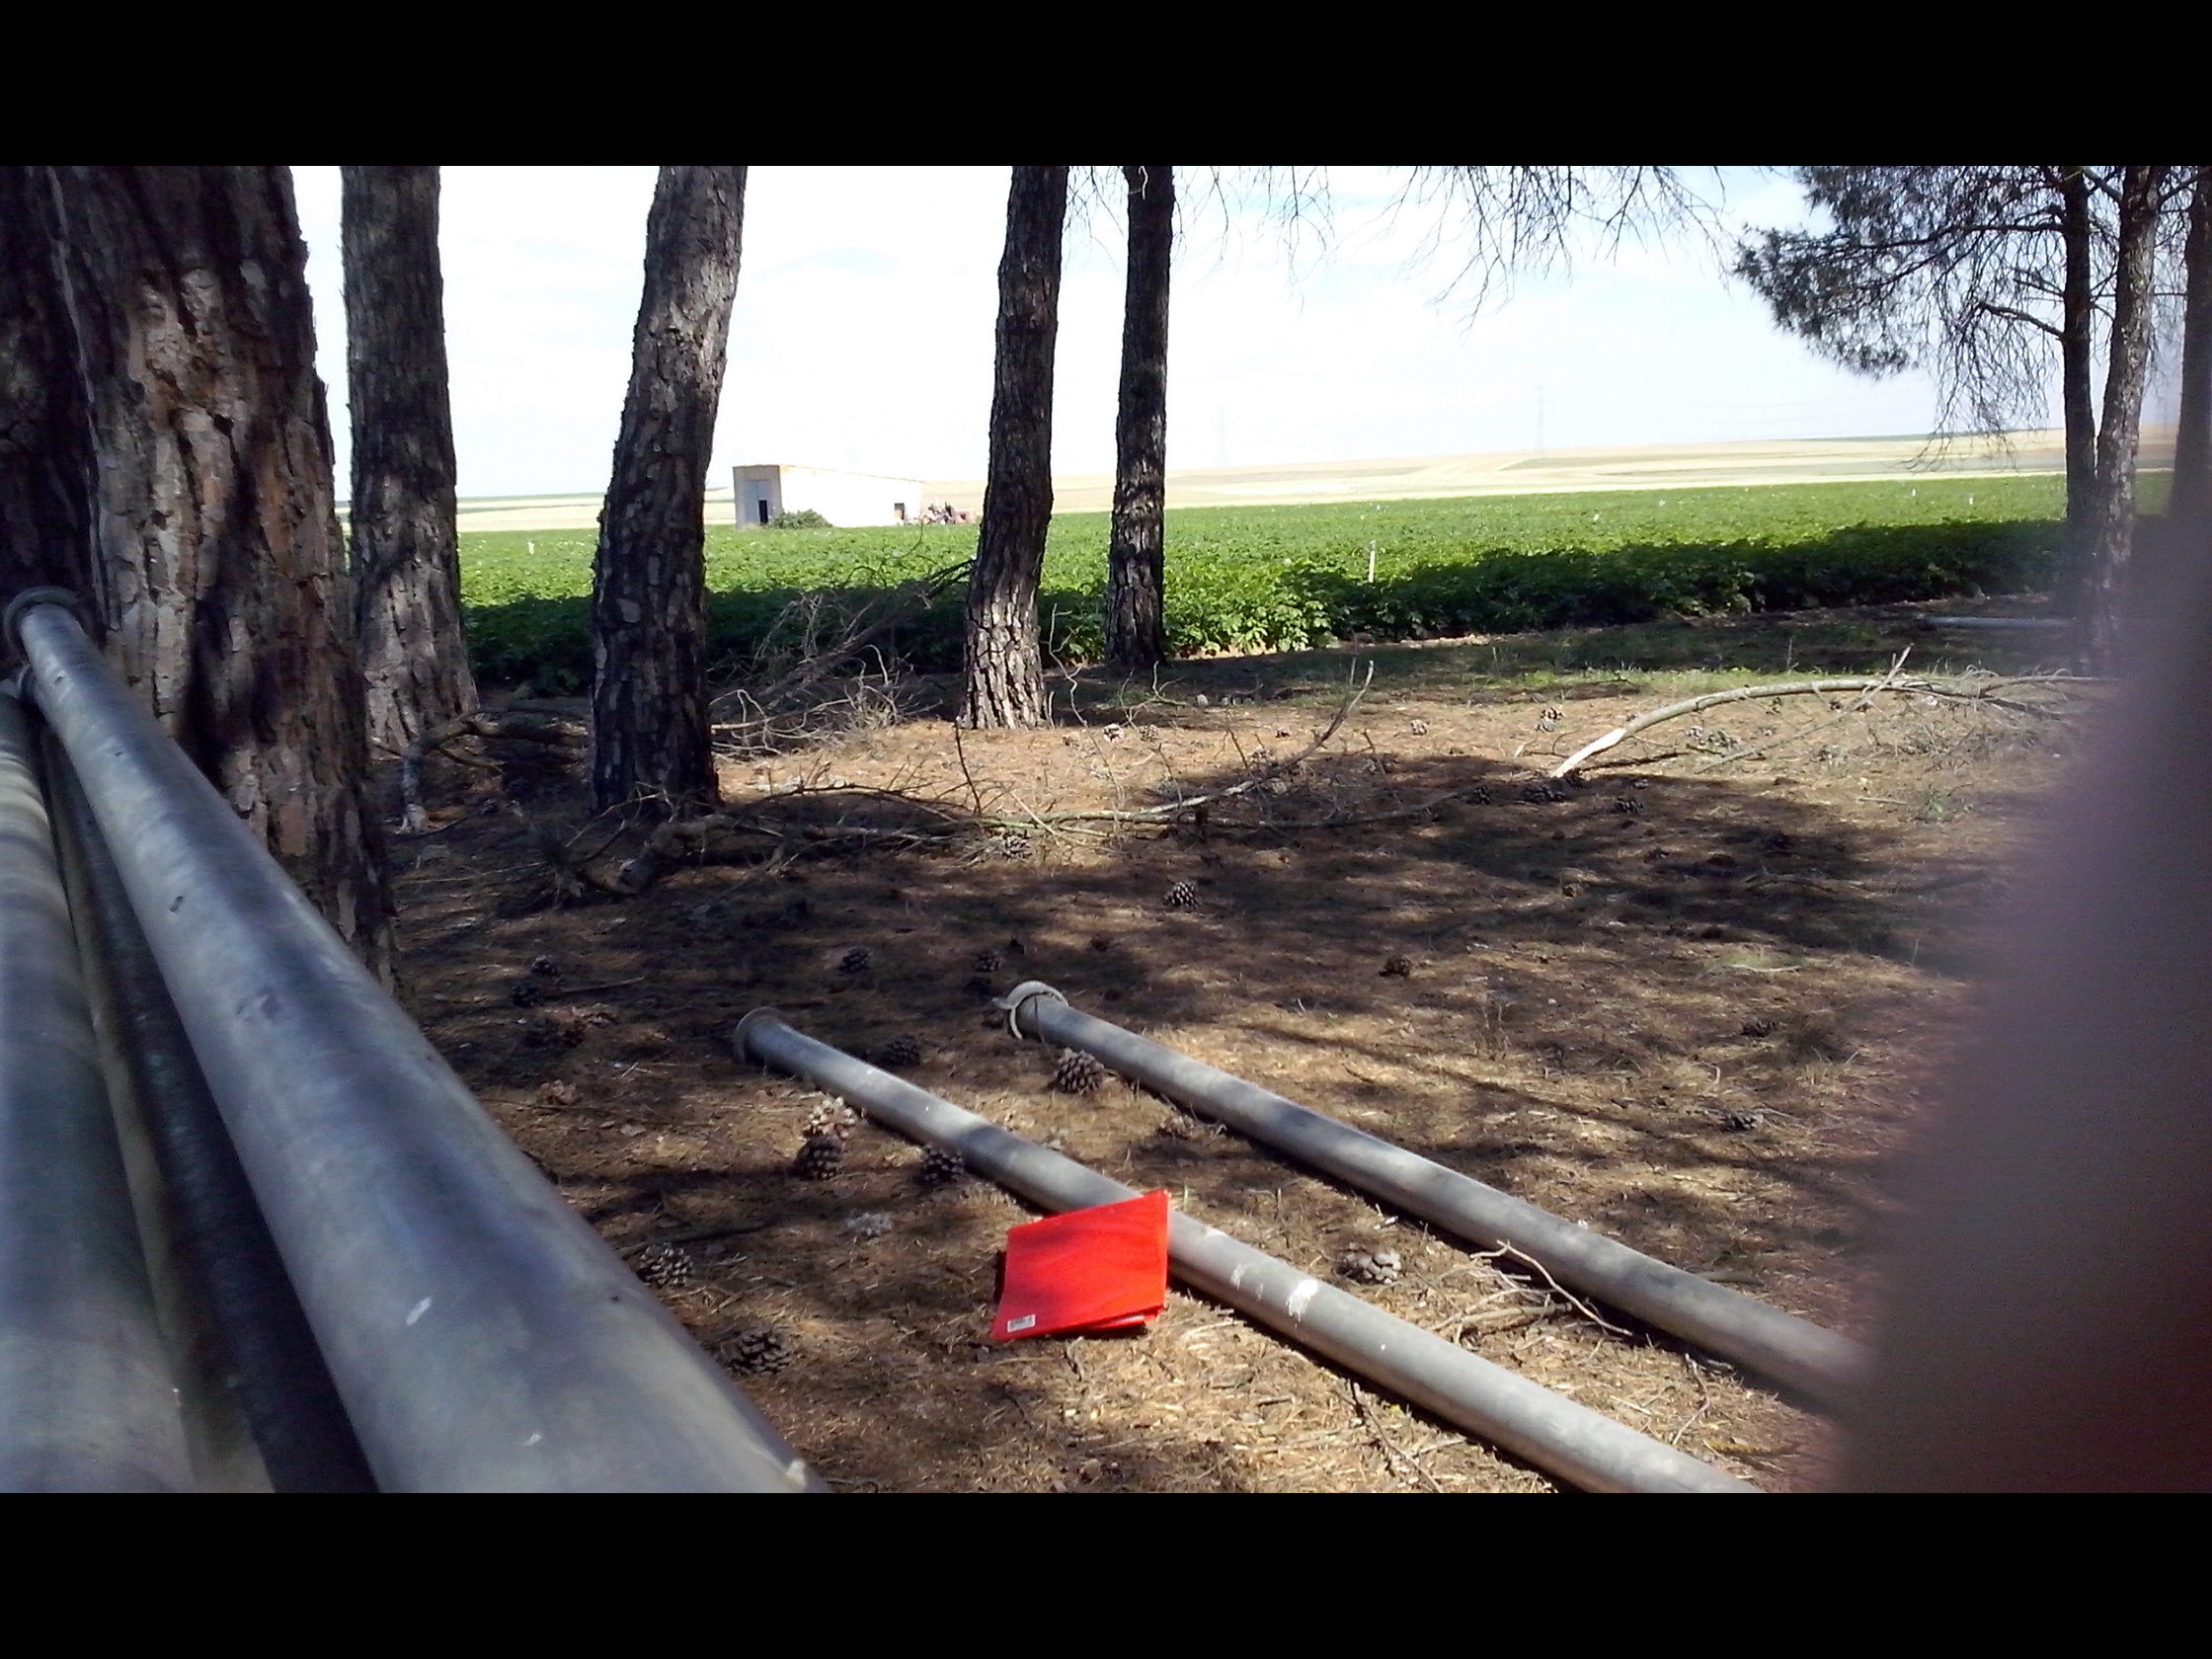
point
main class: Woodland
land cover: Pine dominated coniferous woodland
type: coniferous forest of the mediterranean region
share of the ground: 50 - 75 %
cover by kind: coniferous forest trees 60 %, herbaceous plants 25 %, unconsolidated bare surface 15 %
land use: Forestry
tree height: > 5 m
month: July
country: ES
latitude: 41.5163
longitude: -5.0879
